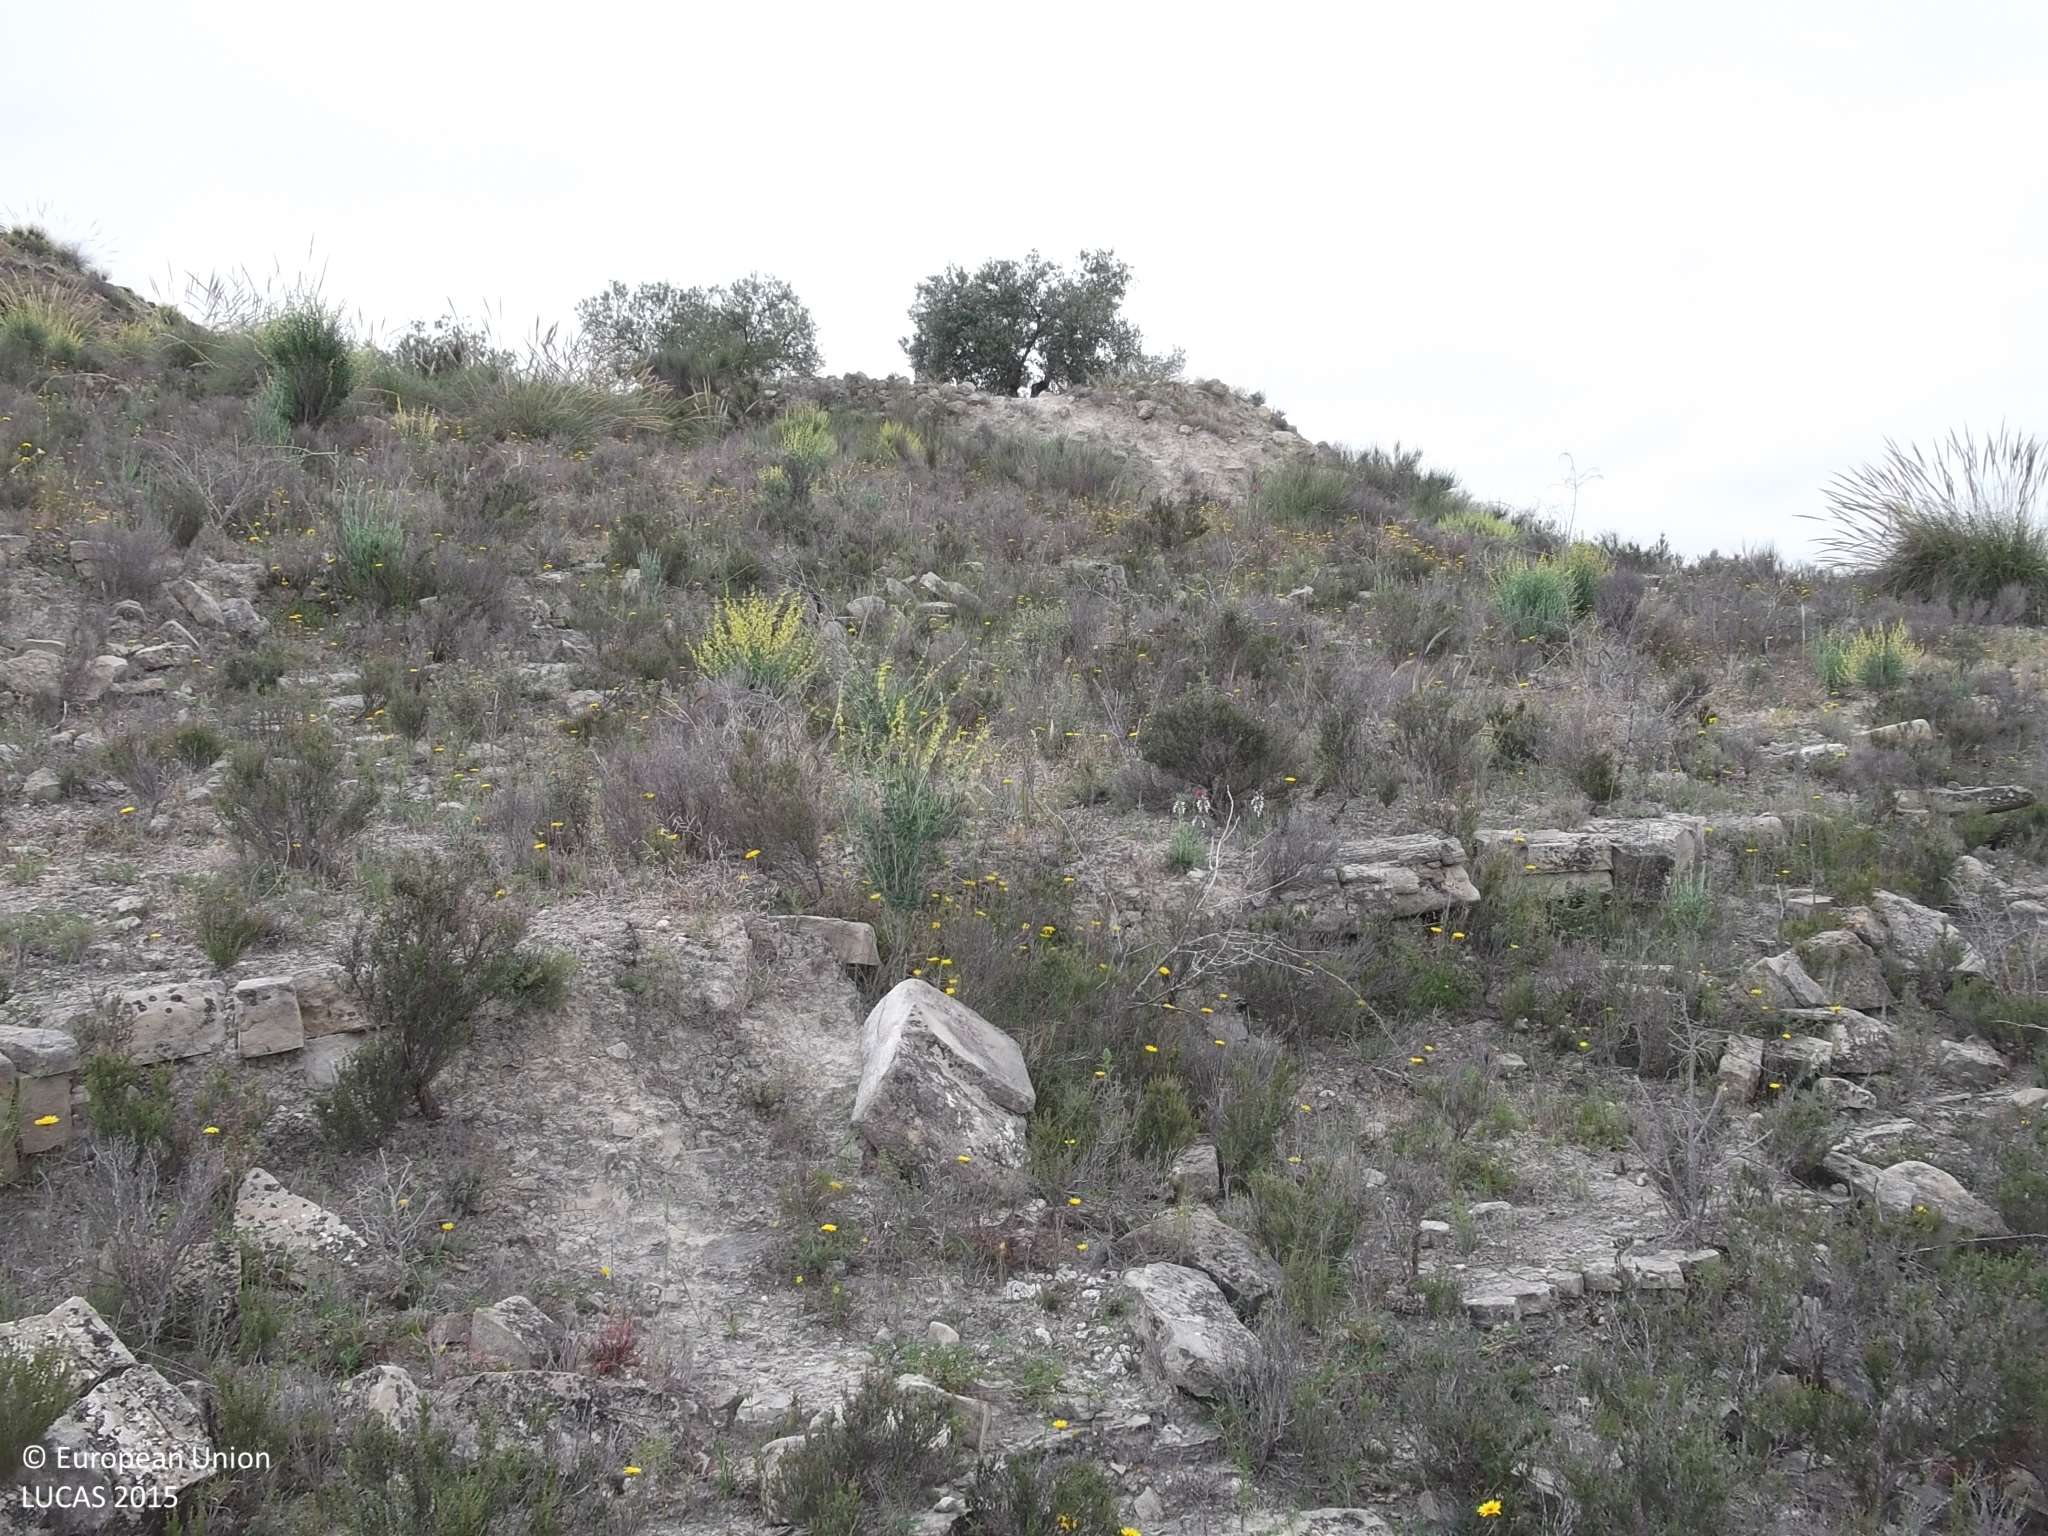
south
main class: Shrubland
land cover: Shrubland without tree cover
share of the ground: 25 - 50 %
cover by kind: herbaceous plants 60 %, shrubs 40 %
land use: Semi-natural and natural areas not in use
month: April
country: ES
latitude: 37.9767
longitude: -1.3806
